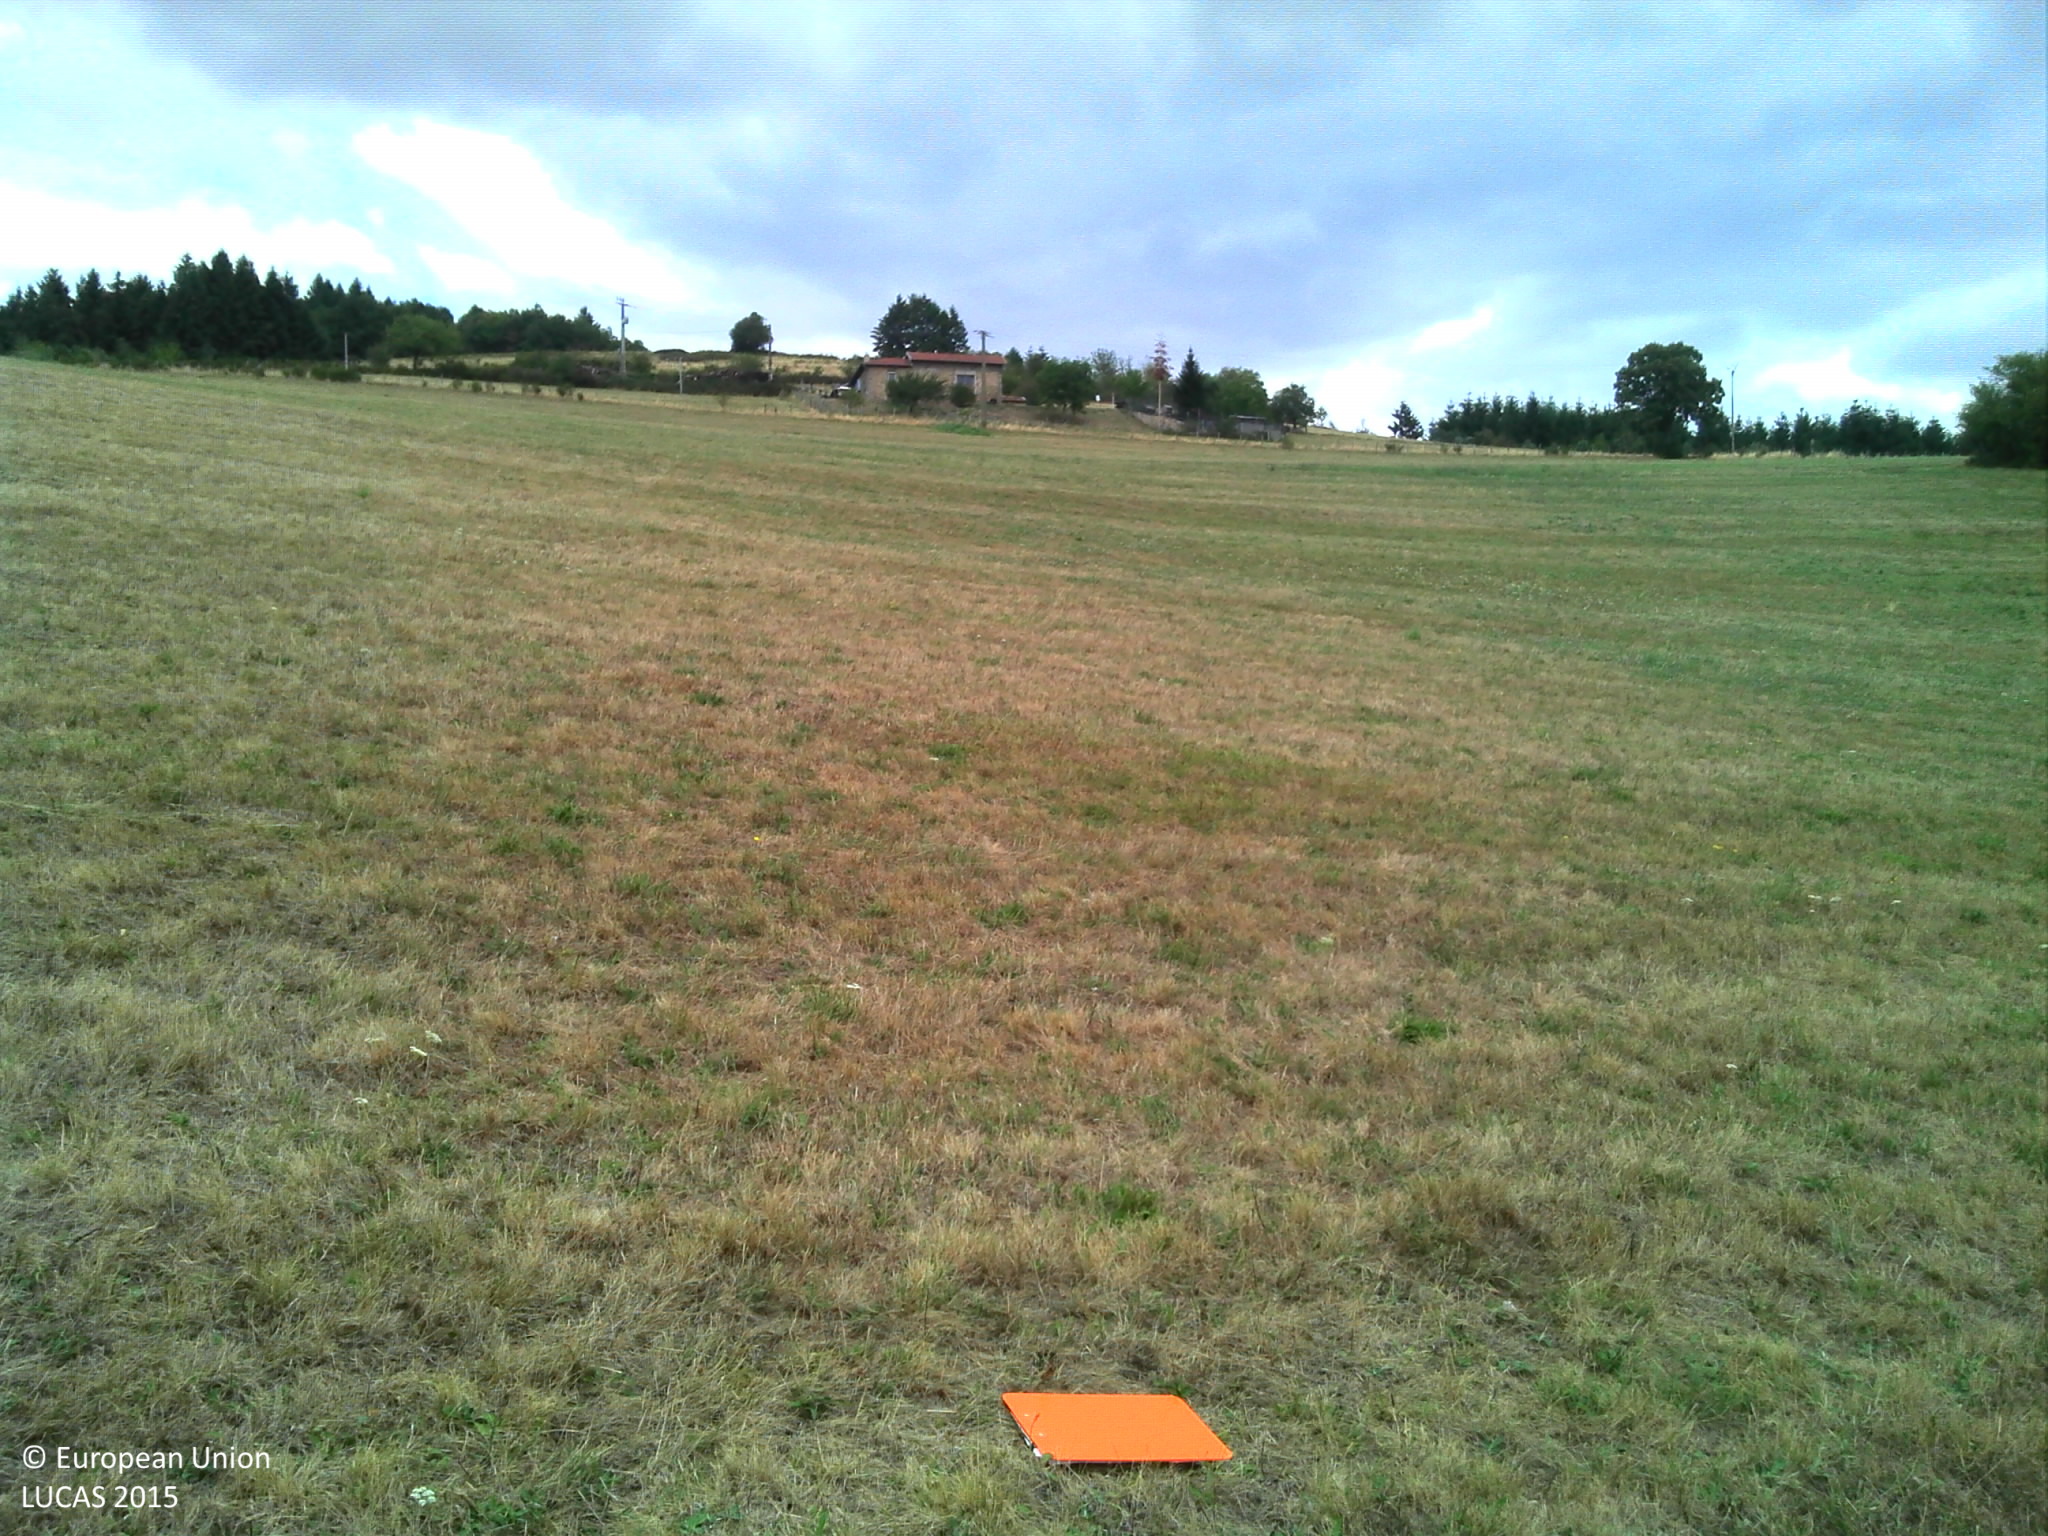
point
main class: Grassland
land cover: Grassland without tree/shrub cover
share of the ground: > 75 %
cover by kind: herbaceous plants 100 %
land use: Agriculture (excluding fallow land and kitchen gardens)
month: August
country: FR
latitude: 46.0657
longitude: 4.5081
